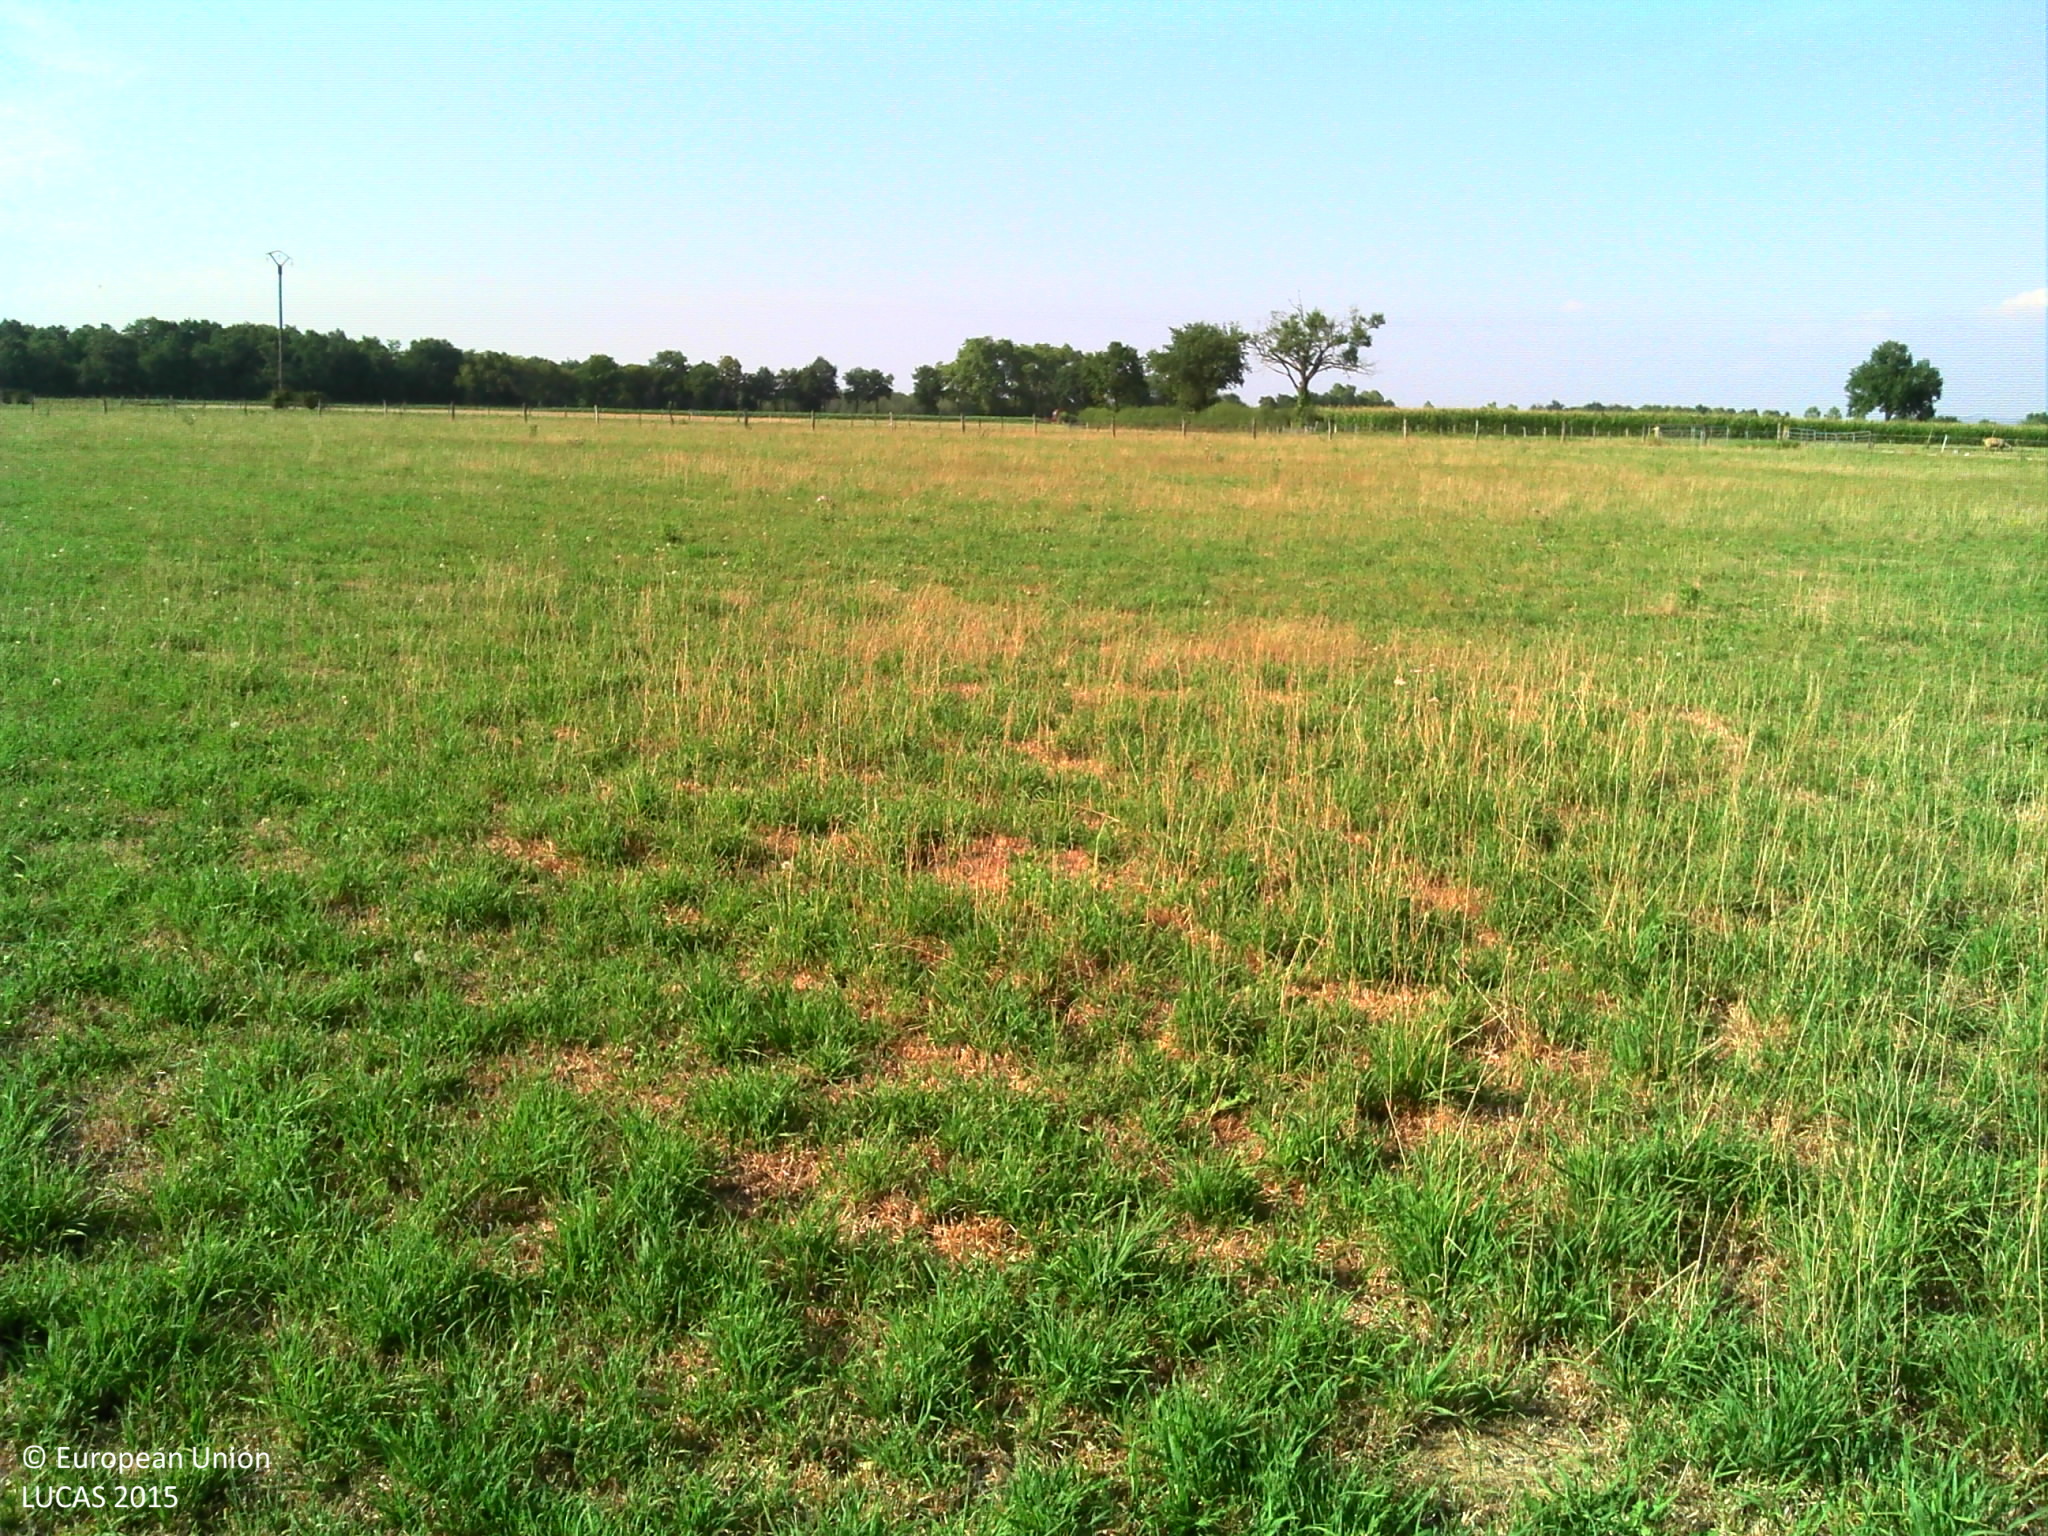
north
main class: Grassland
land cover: Grassland without tree/shrub cover
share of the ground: > 75 %
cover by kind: herbaceous plants 100 %
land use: Agriculture (excluding fallow land and kitchen gardens)
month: August
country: FR
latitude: 45.6832
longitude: 4.1094
